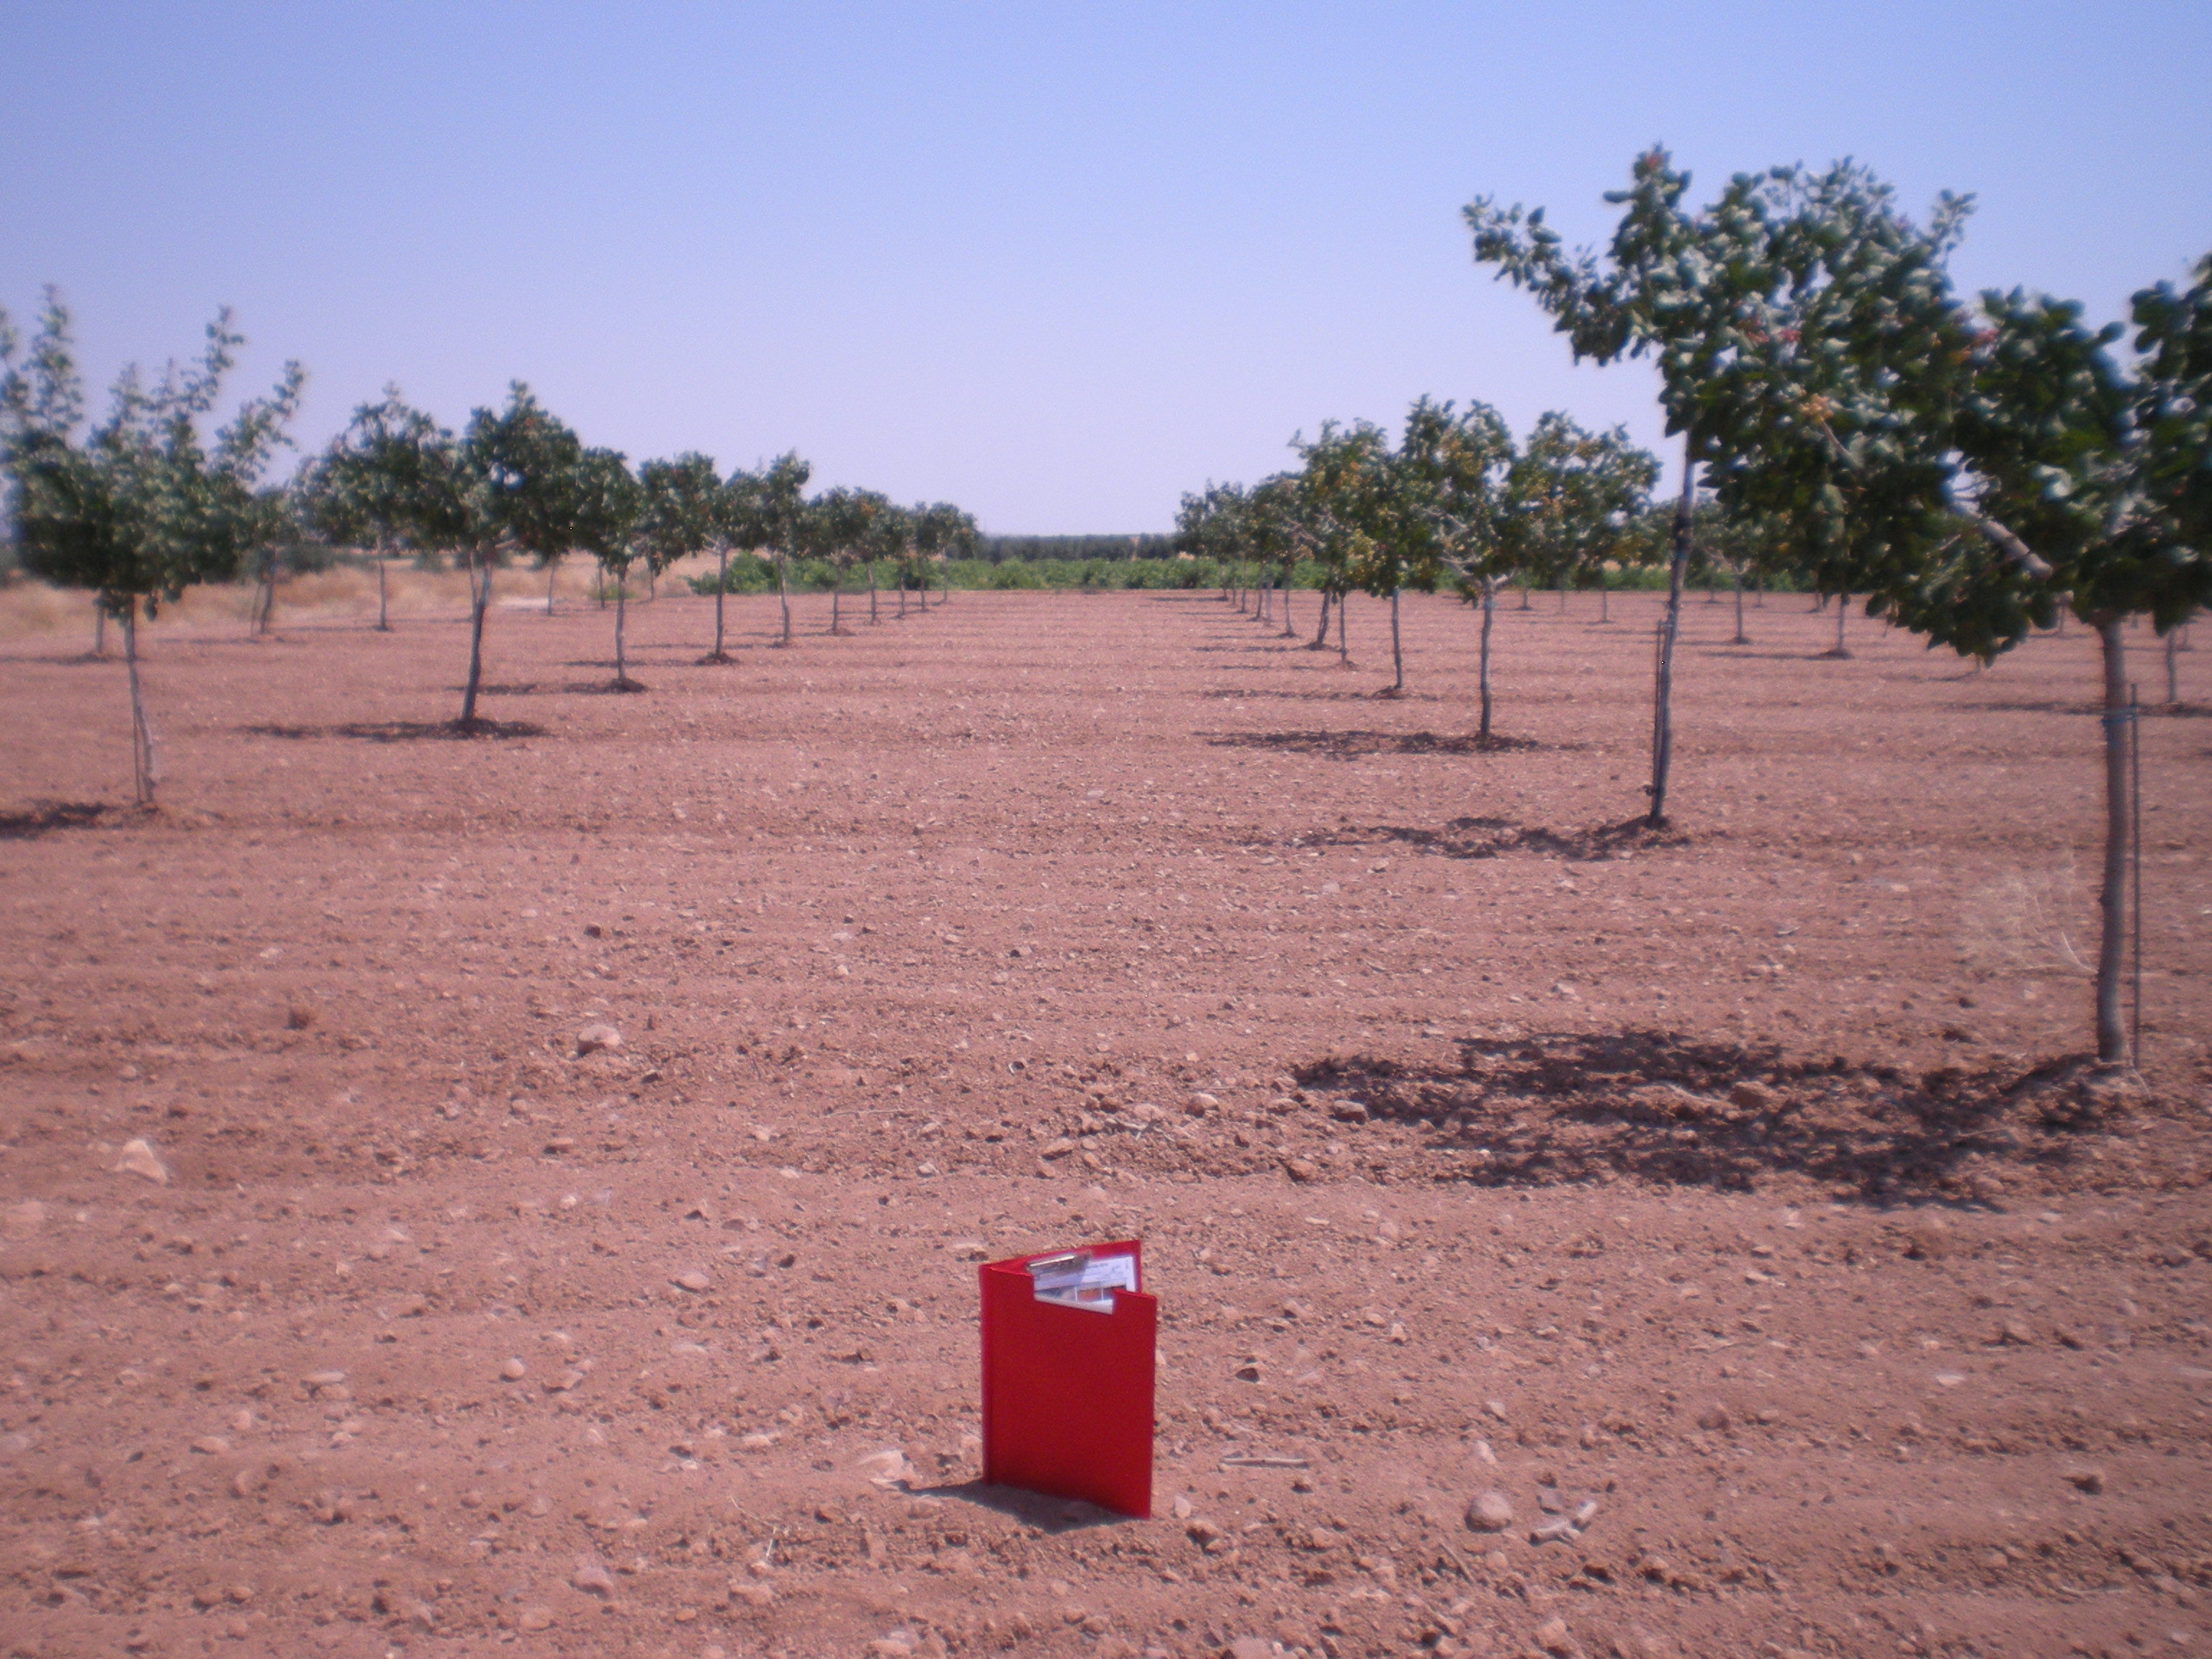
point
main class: Cropland
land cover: Nuts trees
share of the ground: < 10 %
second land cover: Other bare soil
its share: > 75 %
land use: Agriculture (excluding fallow land and kitchen gardens)
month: June
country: ES
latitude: 39.5816
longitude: -3.3999
